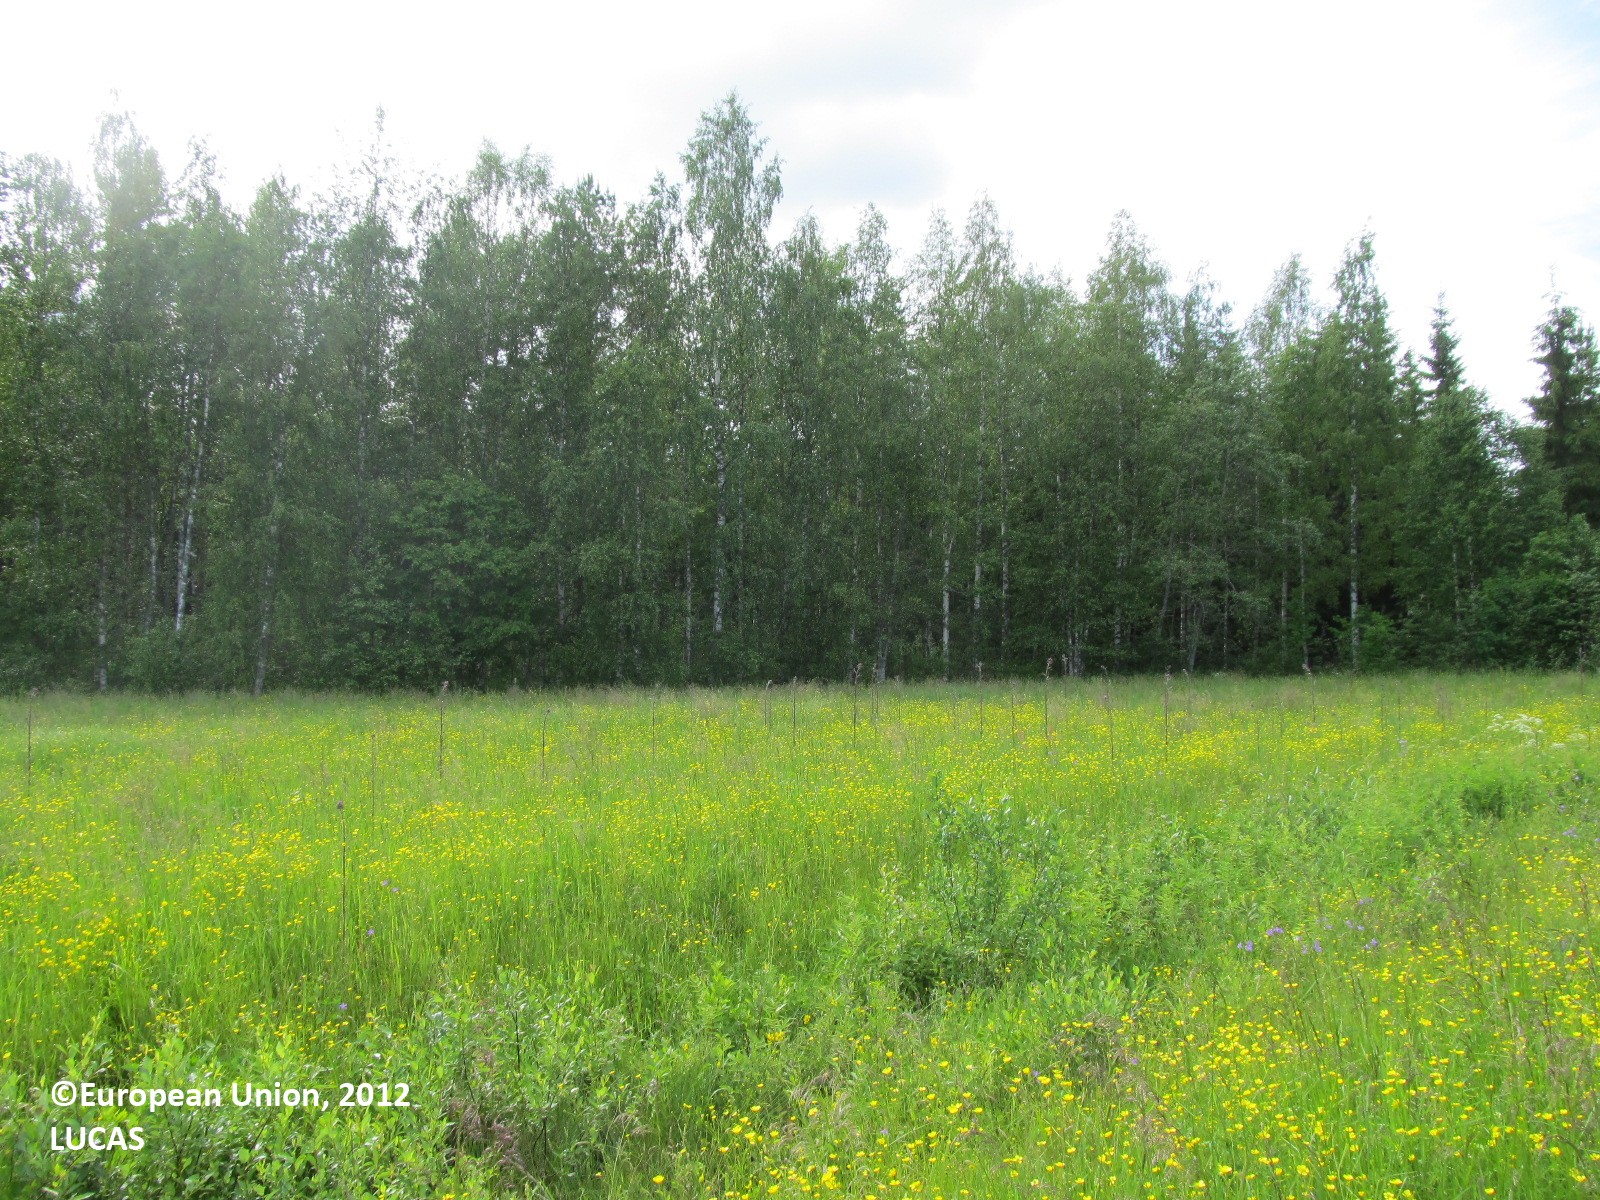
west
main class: Grassland
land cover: Grassland without tree/shrub cover
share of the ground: > 75 %
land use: Agriculture (excluding fallow land and kitchen gardens)
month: June
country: FI
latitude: 62.8092
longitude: 29.2329
